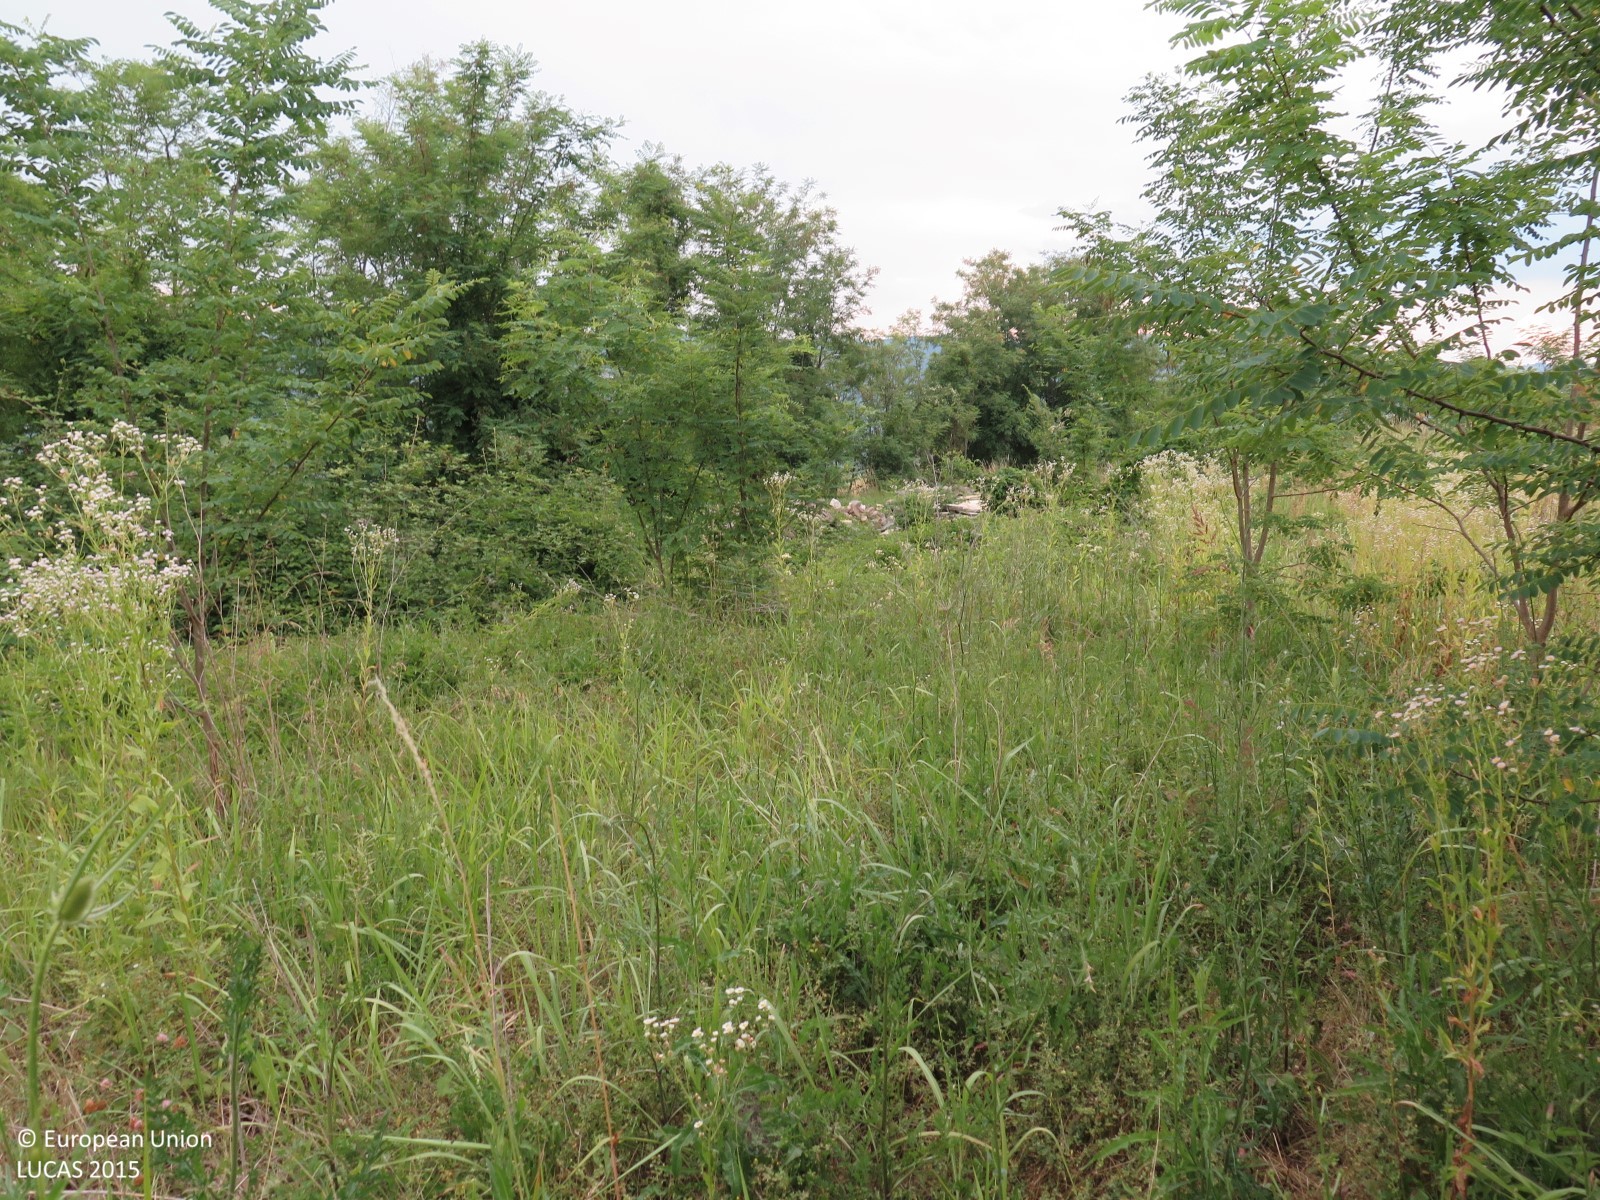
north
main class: Grassland
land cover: Grassland with sparse tree/shrub cover
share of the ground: > 75 %
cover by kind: herbaceous plants 90 %, broadleaved forest trees 5 %, shrubs 5 %
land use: Semi-natural and natural areas not in use
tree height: > 5 m
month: July
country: HR
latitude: 45.3274
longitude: 13.8099
